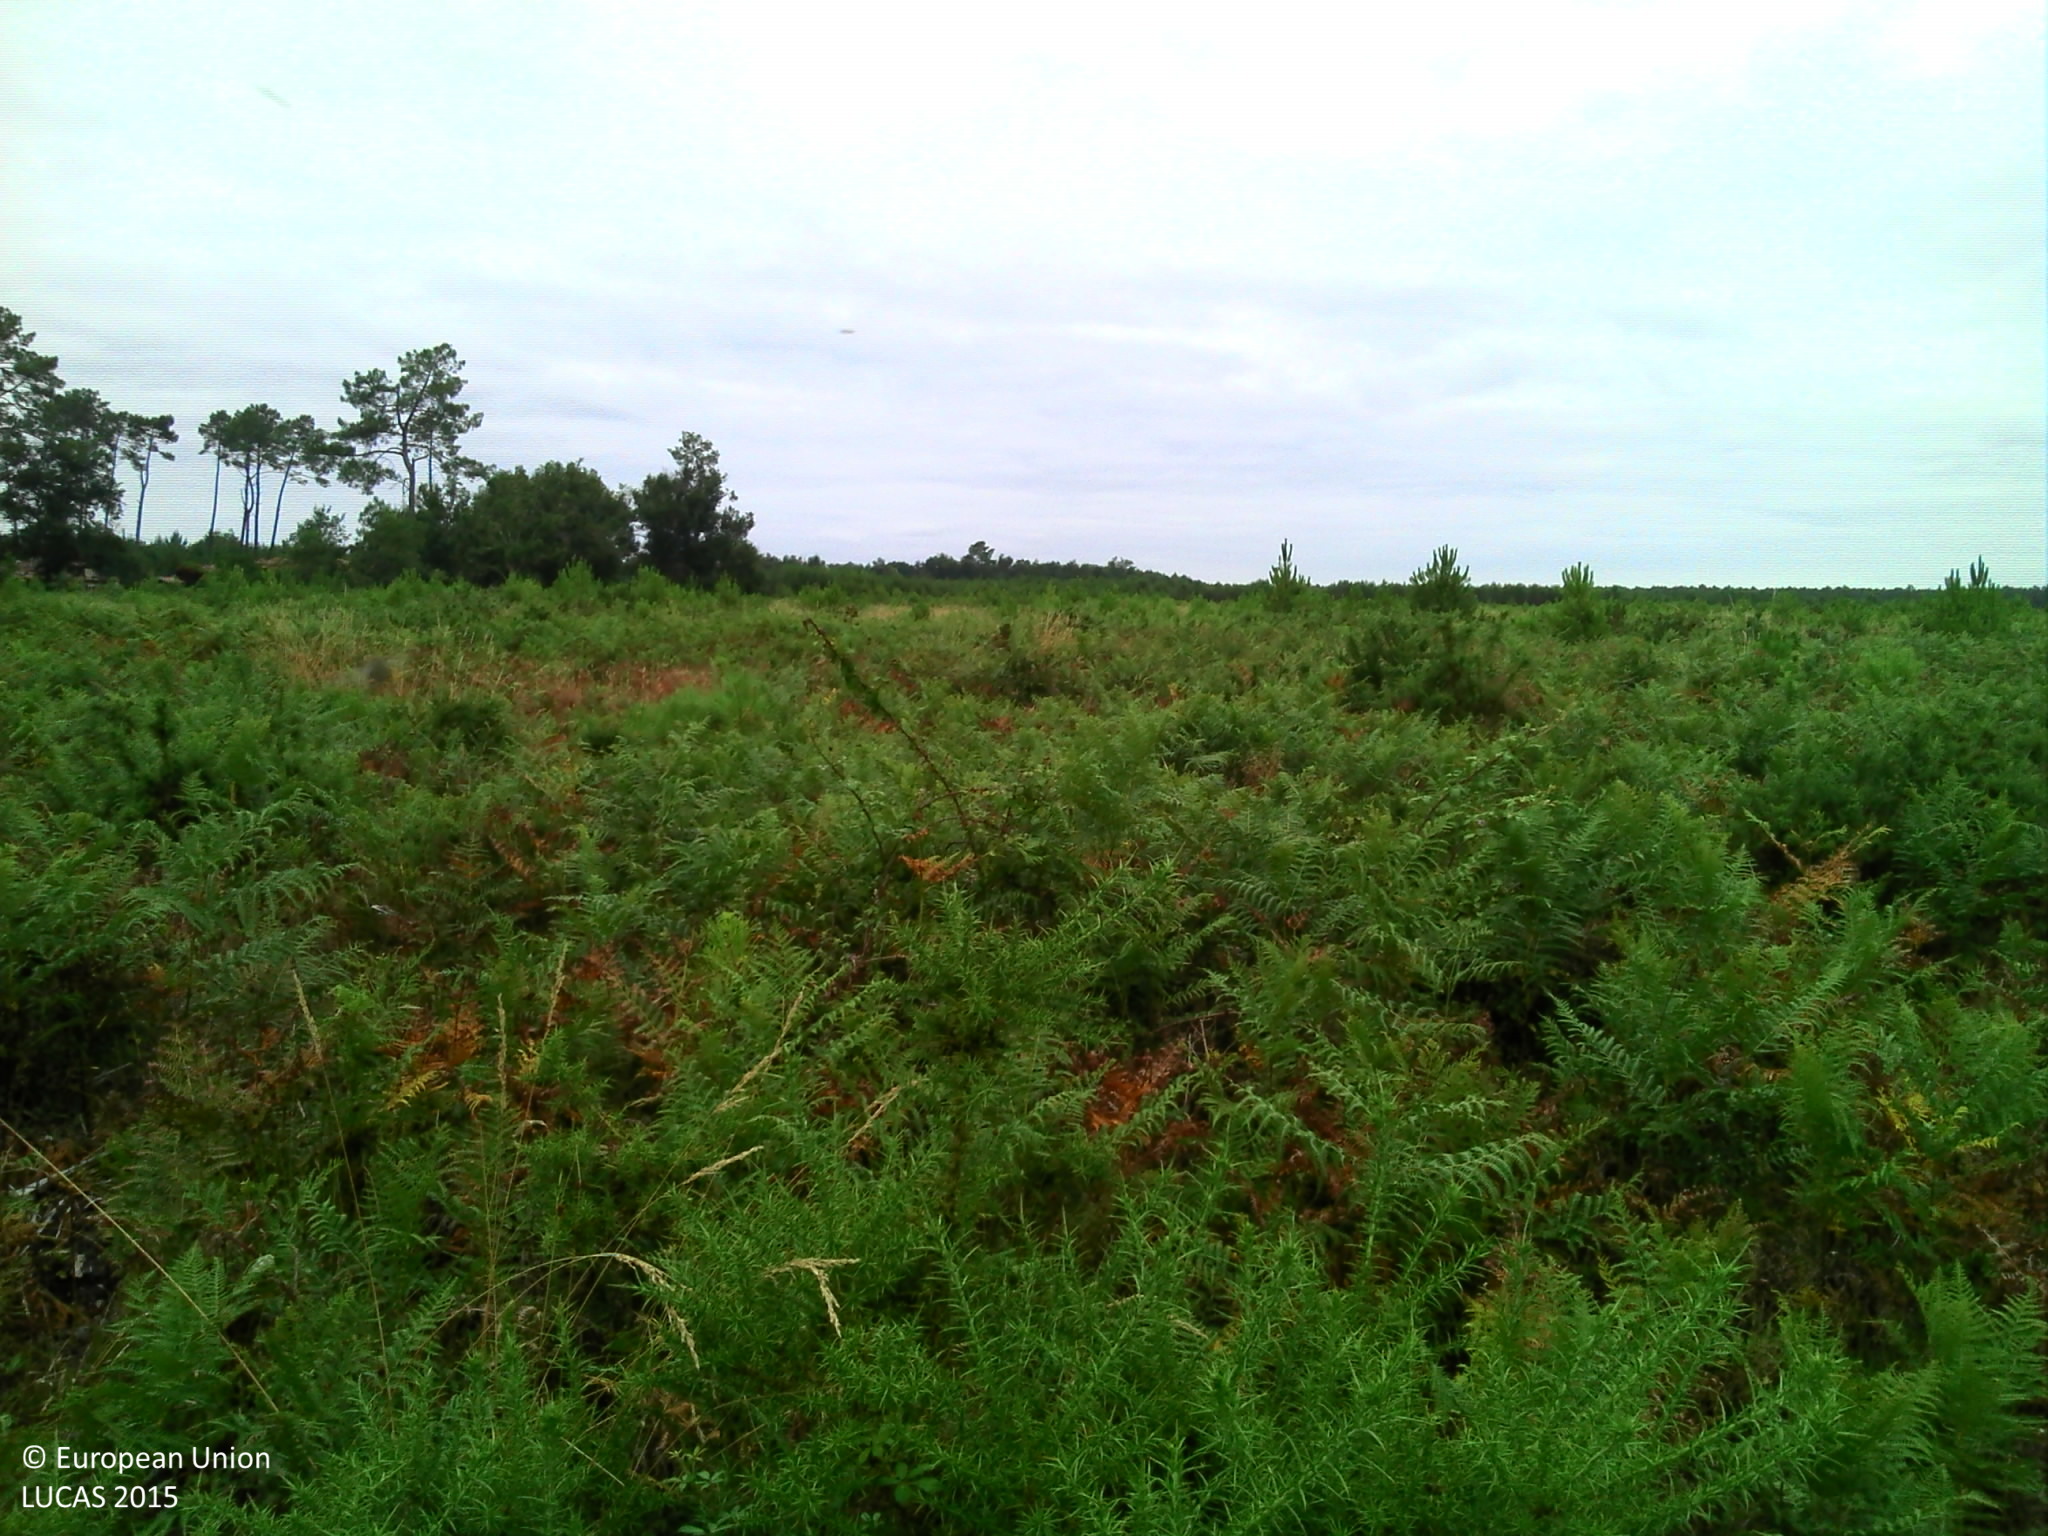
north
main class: Grassland
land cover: Grassland with sparse tree/shrub cover
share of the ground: > 75 %
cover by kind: herbaceous plants 85 %, shrubs 10 %, coniferous forest trees 5 %
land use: Forestry
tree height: < 5 m
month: July
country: FR
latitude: 43.9101
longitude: -1.1628
